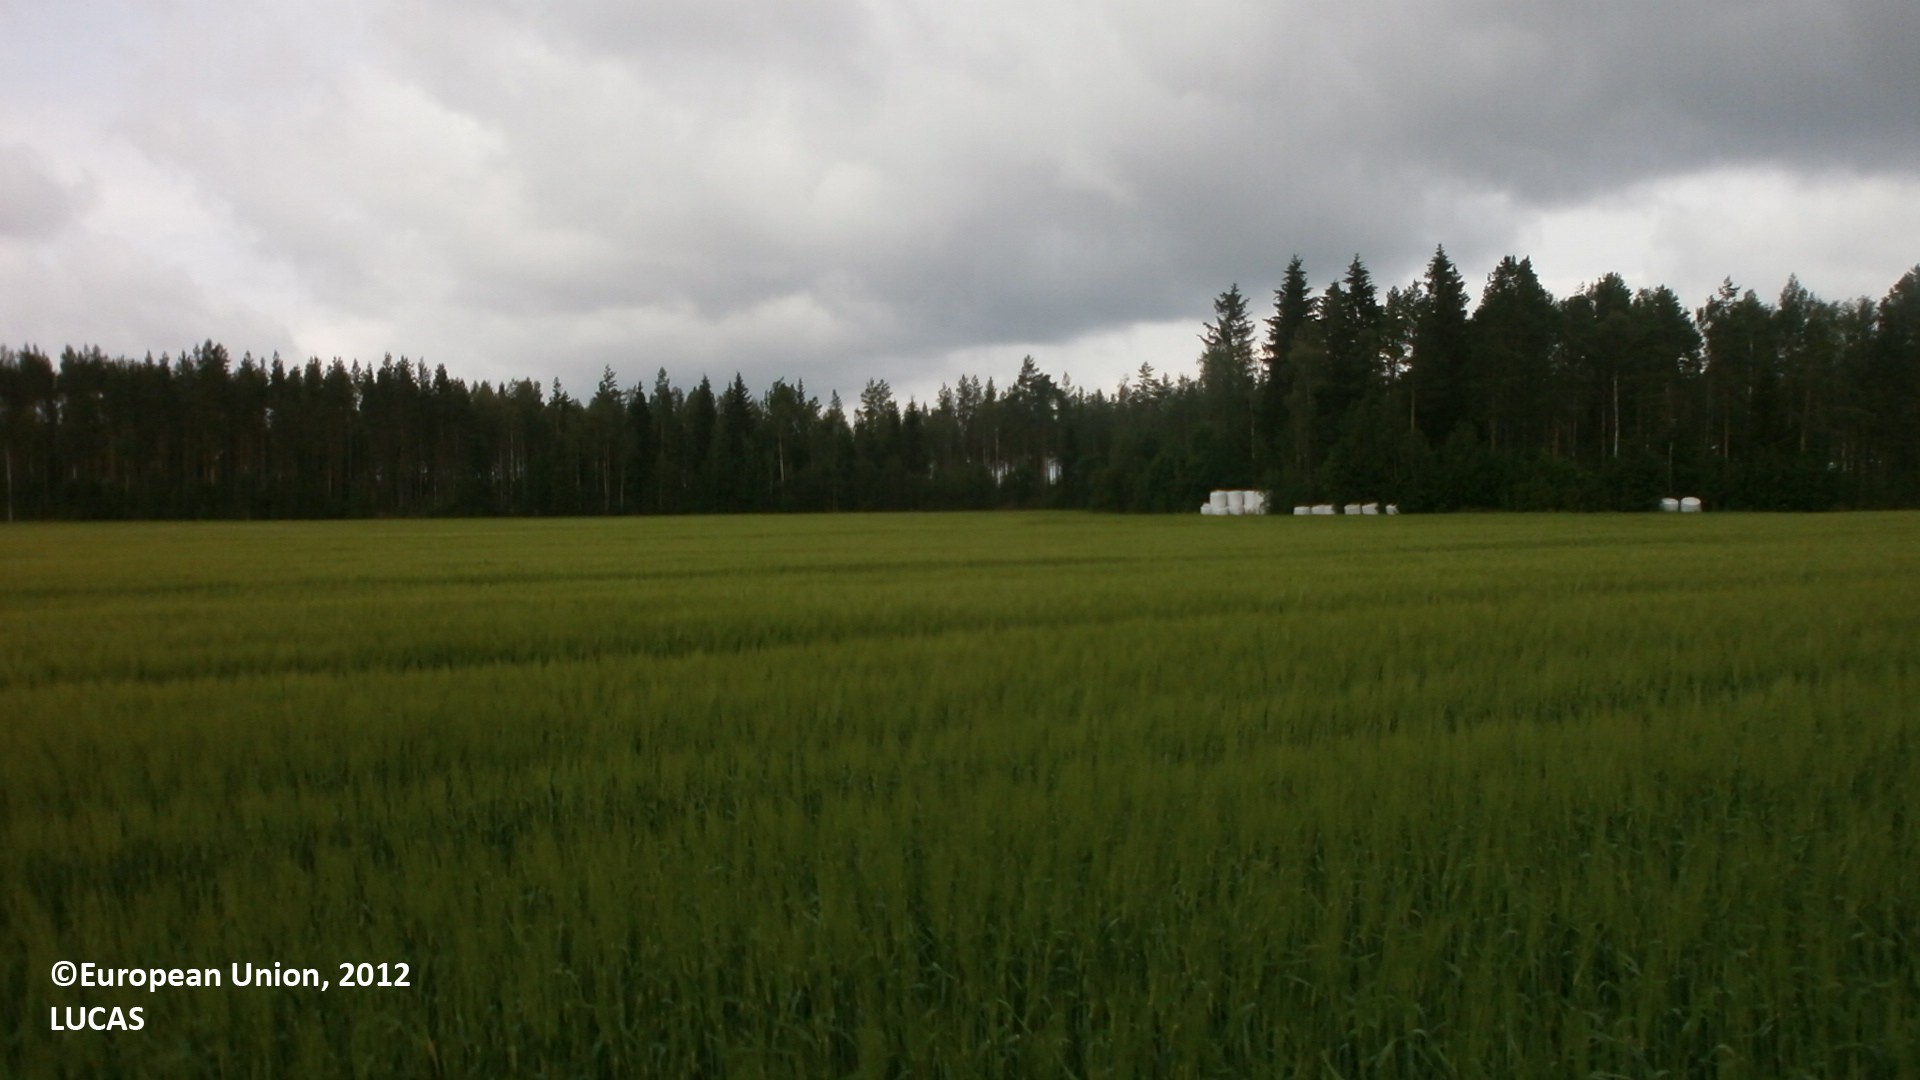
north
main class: Cropland
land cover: Barley
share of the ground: > 75 %
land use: Agriculture (excluding fallow land and kitchen gardens)
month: July
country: FI
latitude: 64.1851
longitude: 24.3328
